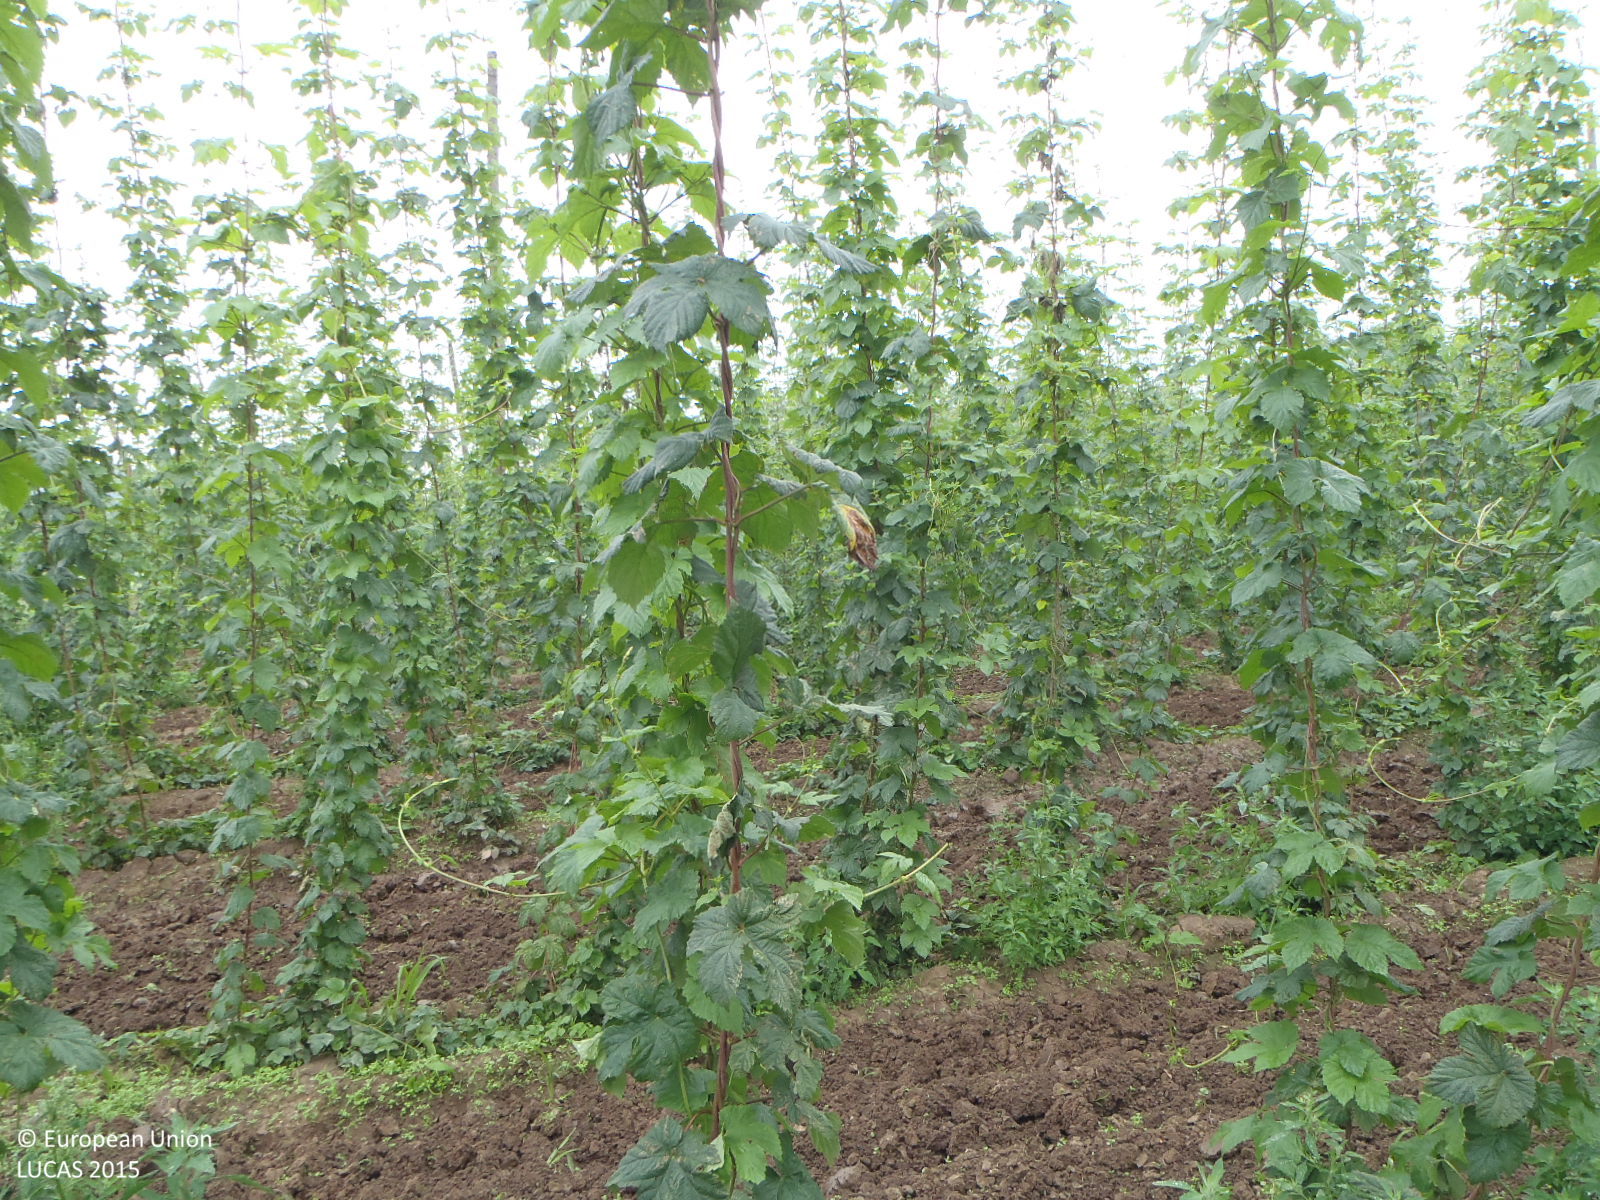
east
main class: Cropland
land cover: Other non-permanent industrial crops
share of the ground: 50 - 75 %
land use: Agriculture (excluding fallow land and kitchen gardens)
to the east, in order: Other non-permanent industrial crops; Grassland without tree/shrub cover; Maize; Broadleaved woodland; Maize
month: June
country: CZ
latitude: 50.3726
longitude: 13.8111
